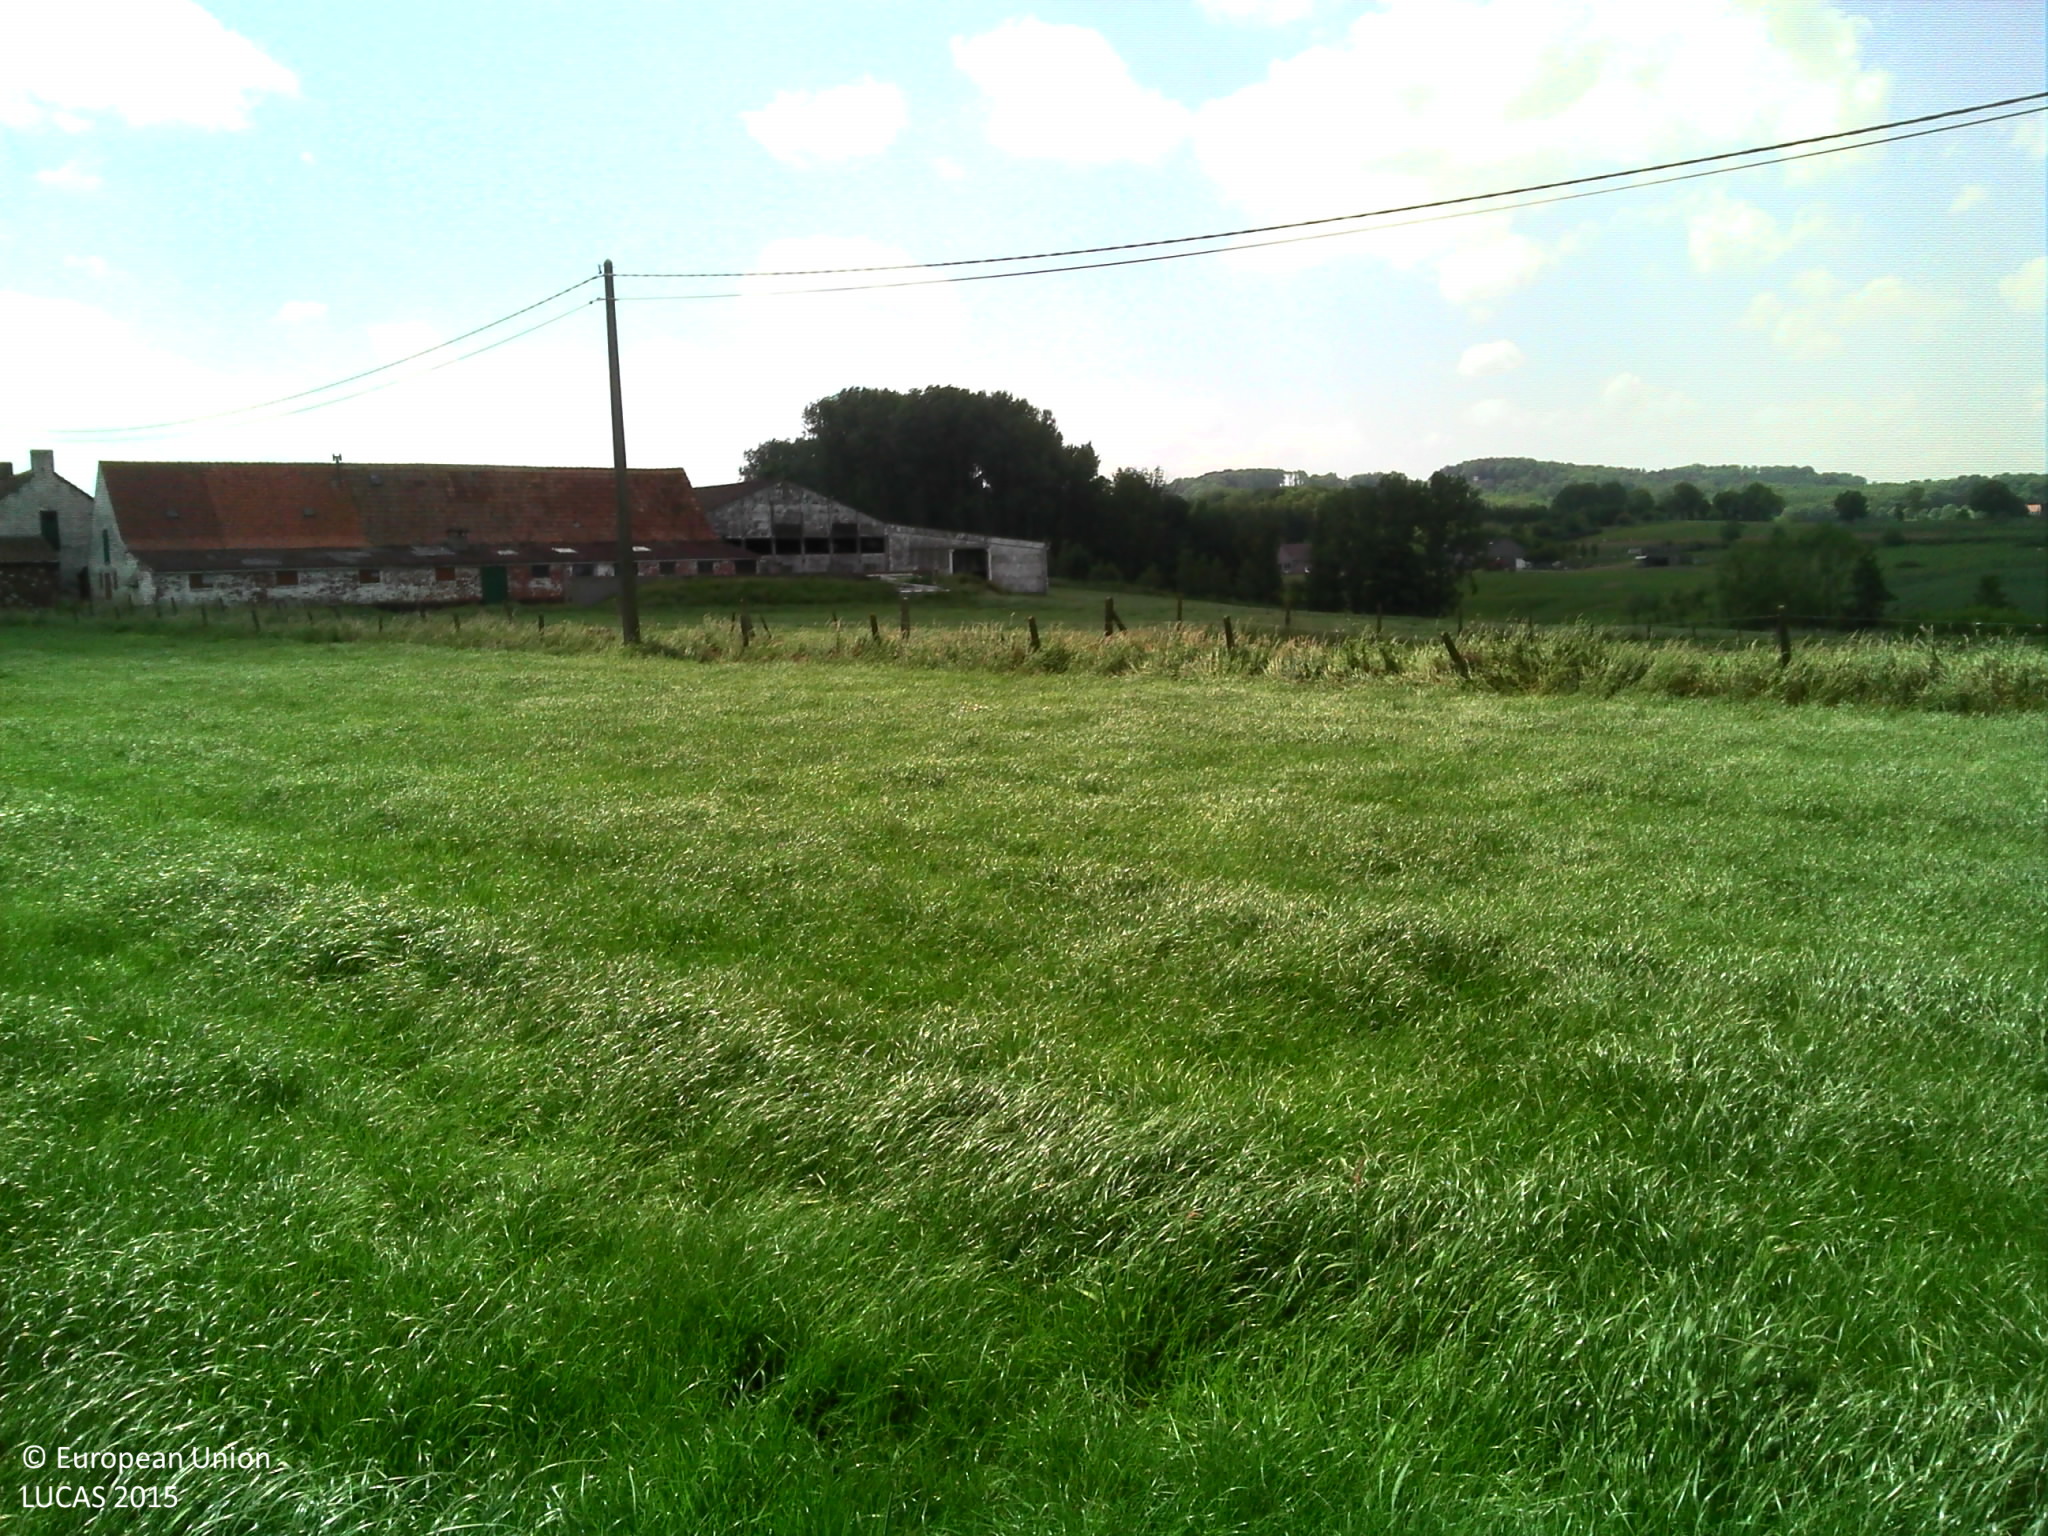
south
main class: Grassland
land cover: Grassland without tree/shrub cover
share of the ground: > 75 %
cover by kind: herbaceous plants 100 %
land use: Agriculture (excluding fallow land and kitchen gardens)
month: June
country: BE
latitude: 50.8029
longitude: 2.7662
